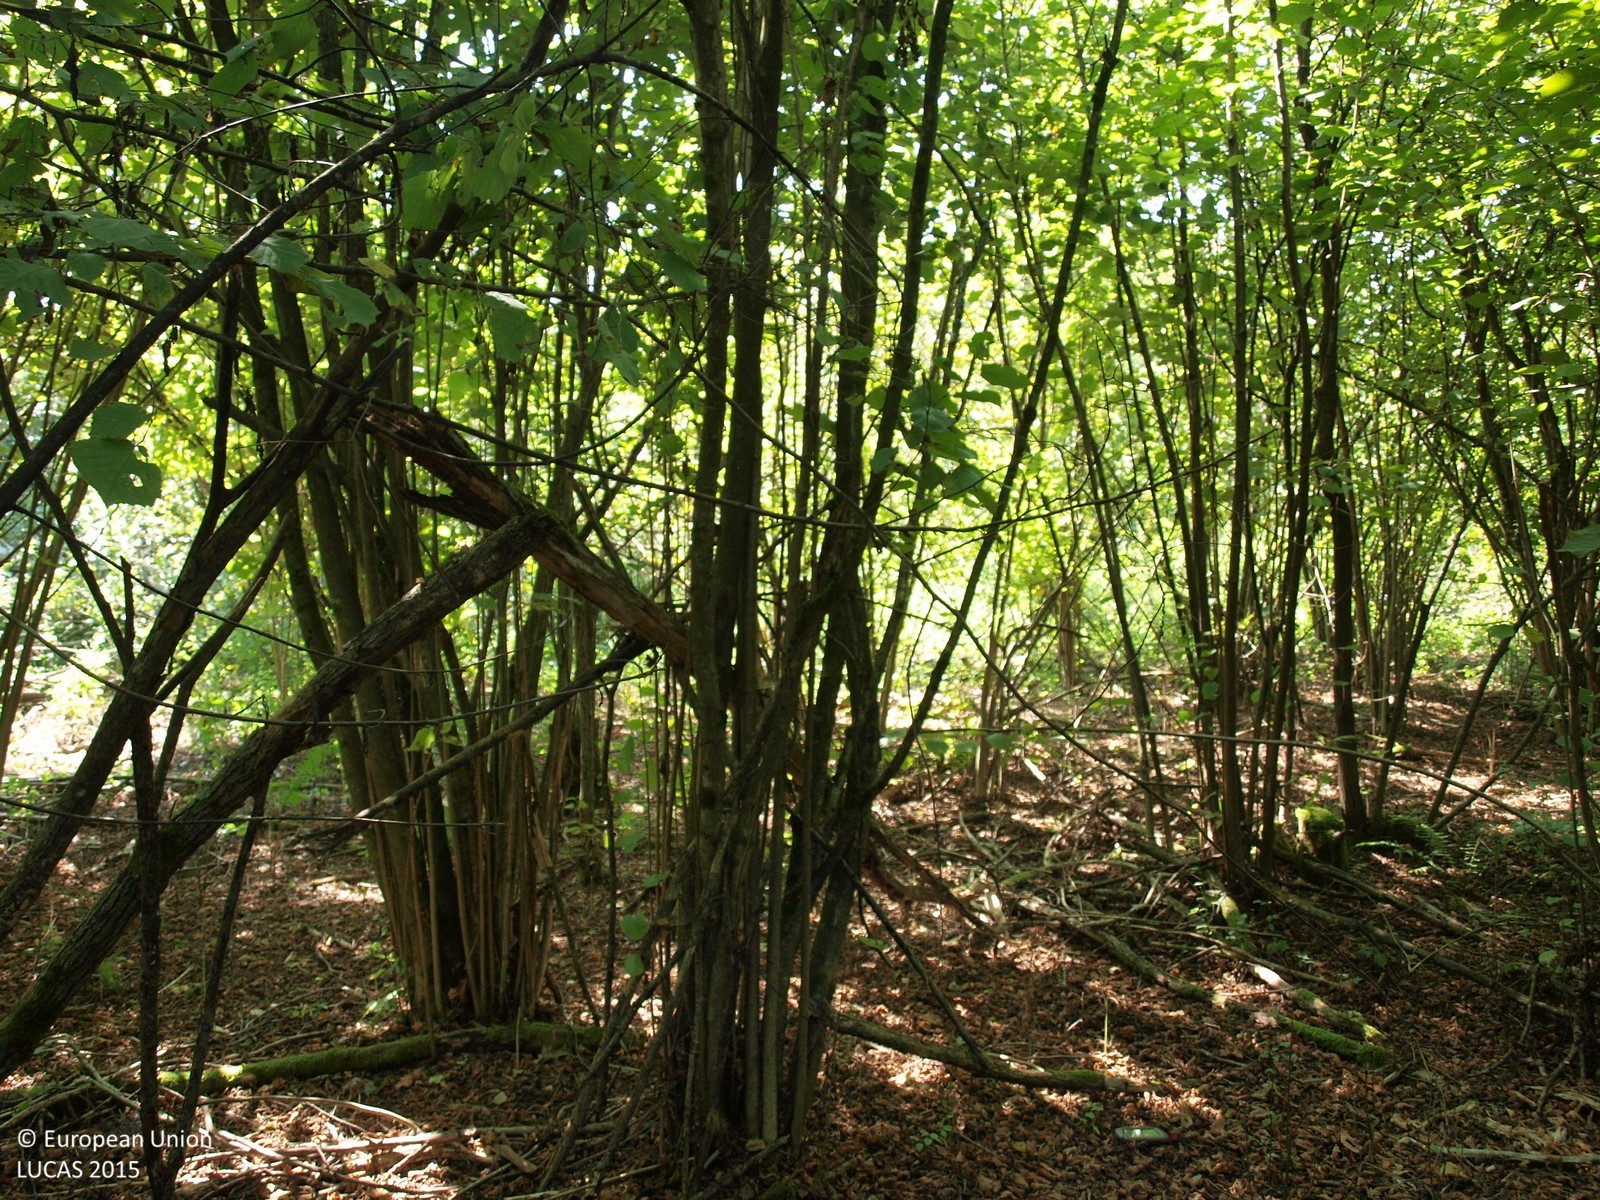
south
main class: Woodland
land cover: Broadleaved woodland
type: mesophytic deciduous forest
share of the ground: > 75 %
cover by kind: broadleaved forest trees 100 %
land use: Forestry
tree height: > 5 m
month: August
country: HR
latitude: 45.6636
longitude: 16.5317
